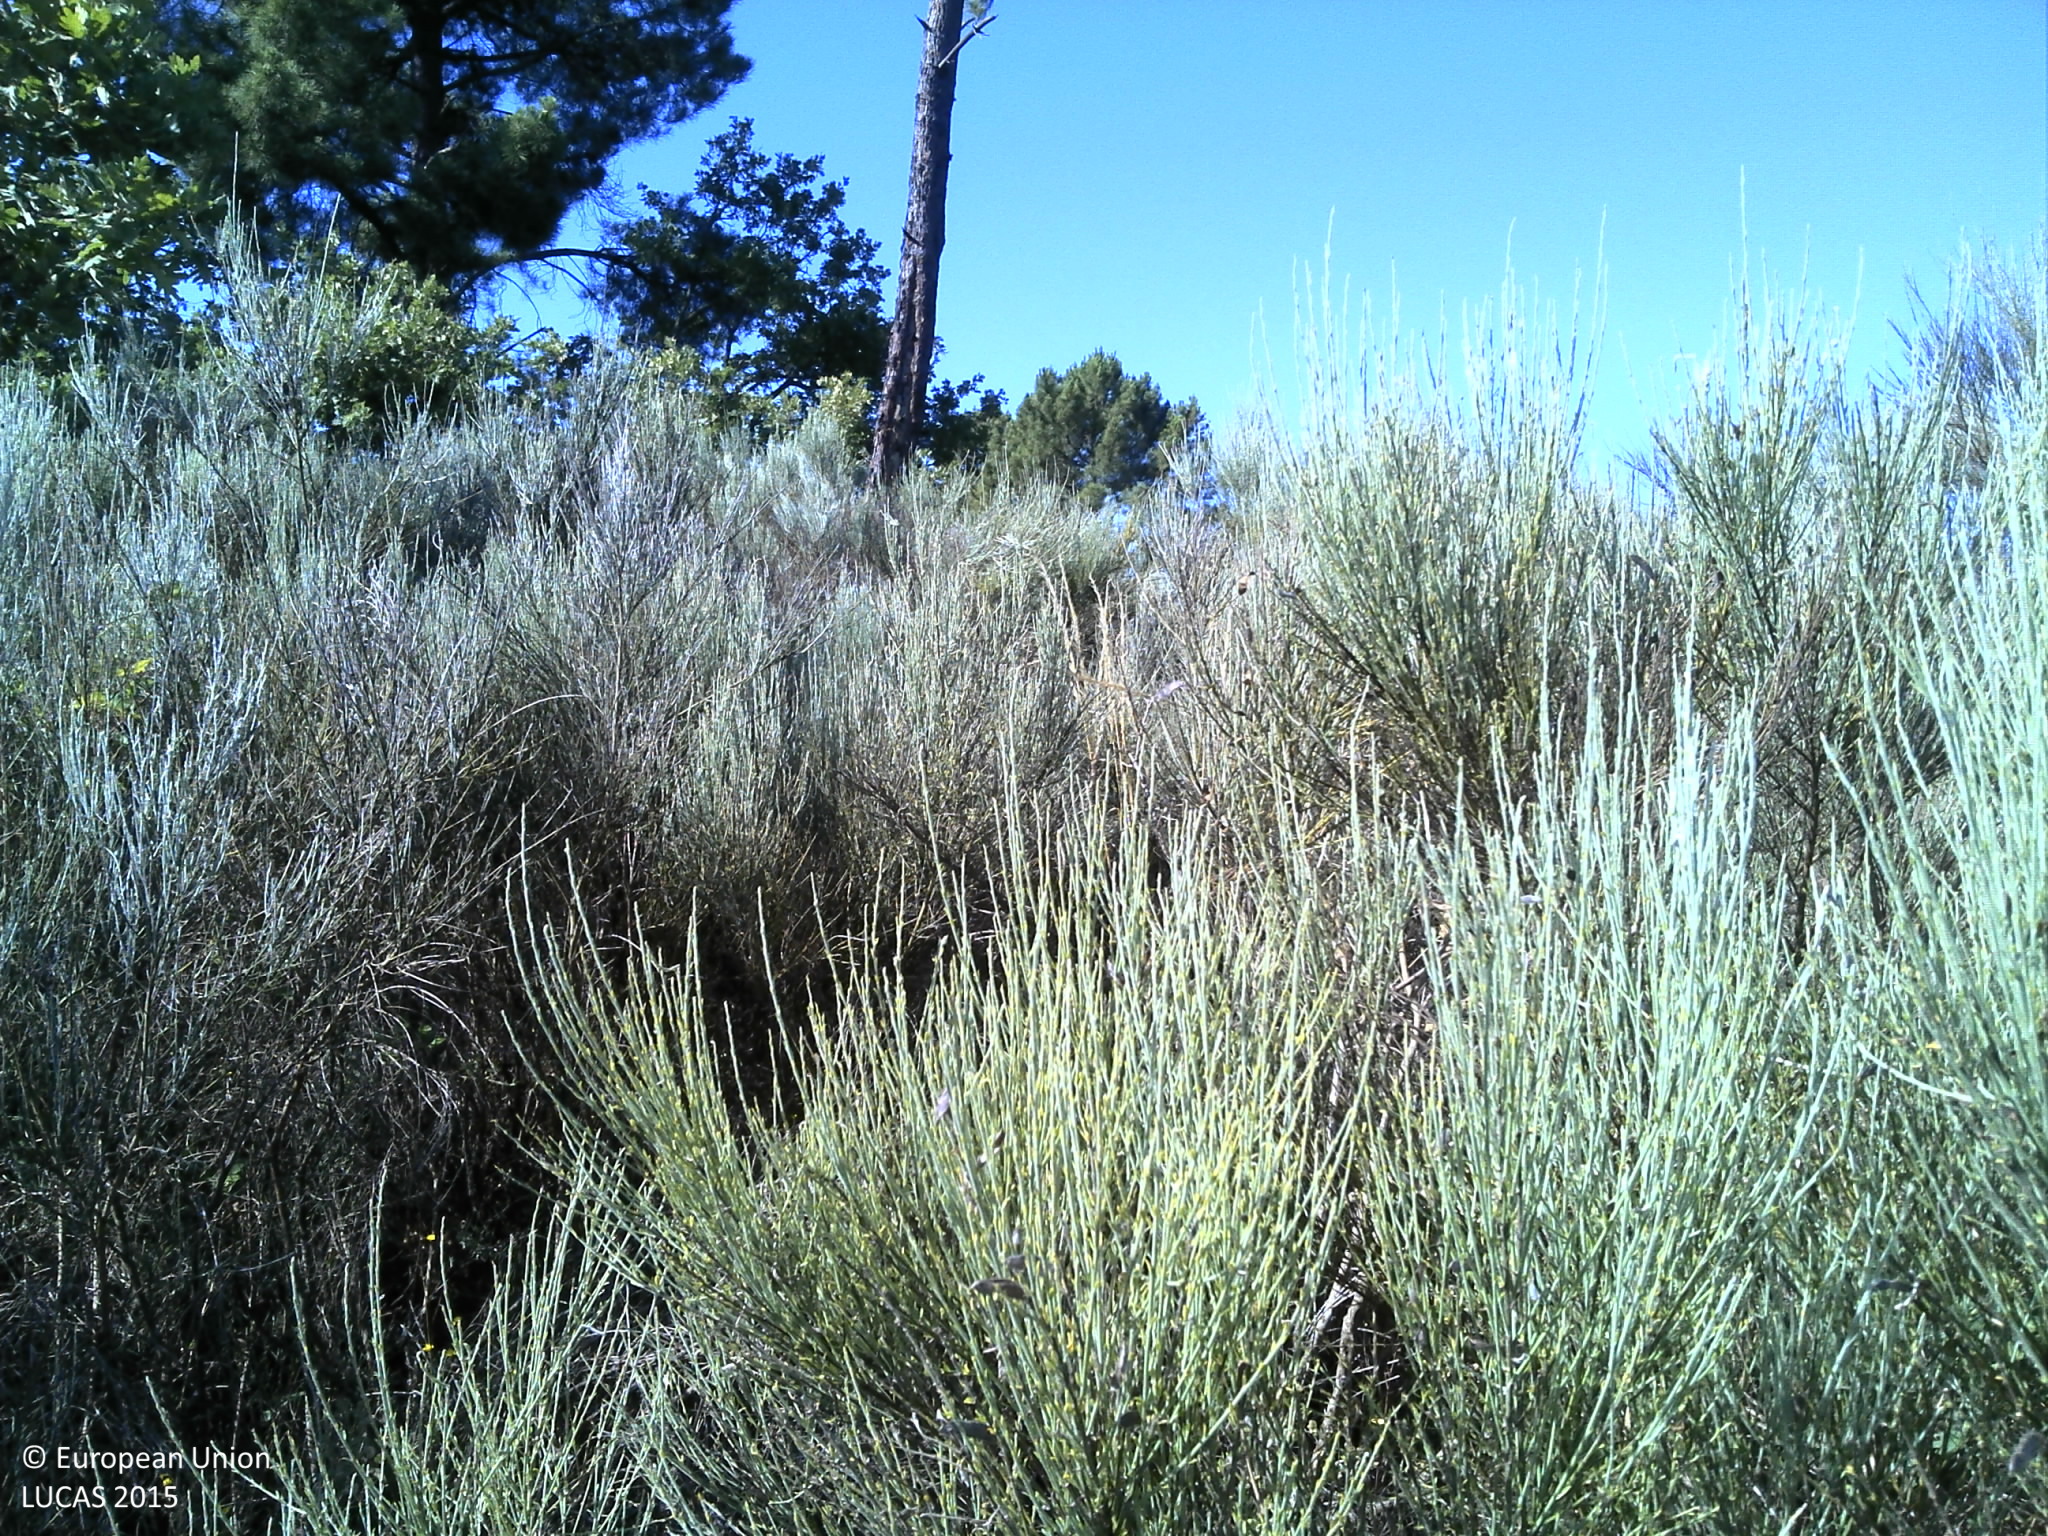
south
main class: Woodland
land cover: Broadleaved woodland
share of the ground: 10 - 25 %
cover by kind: shrubs 90 %, broadleaved forest trees 10 %
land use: Abandoned areas
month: June
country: PT
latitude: 40.8123
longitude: -7.2401
